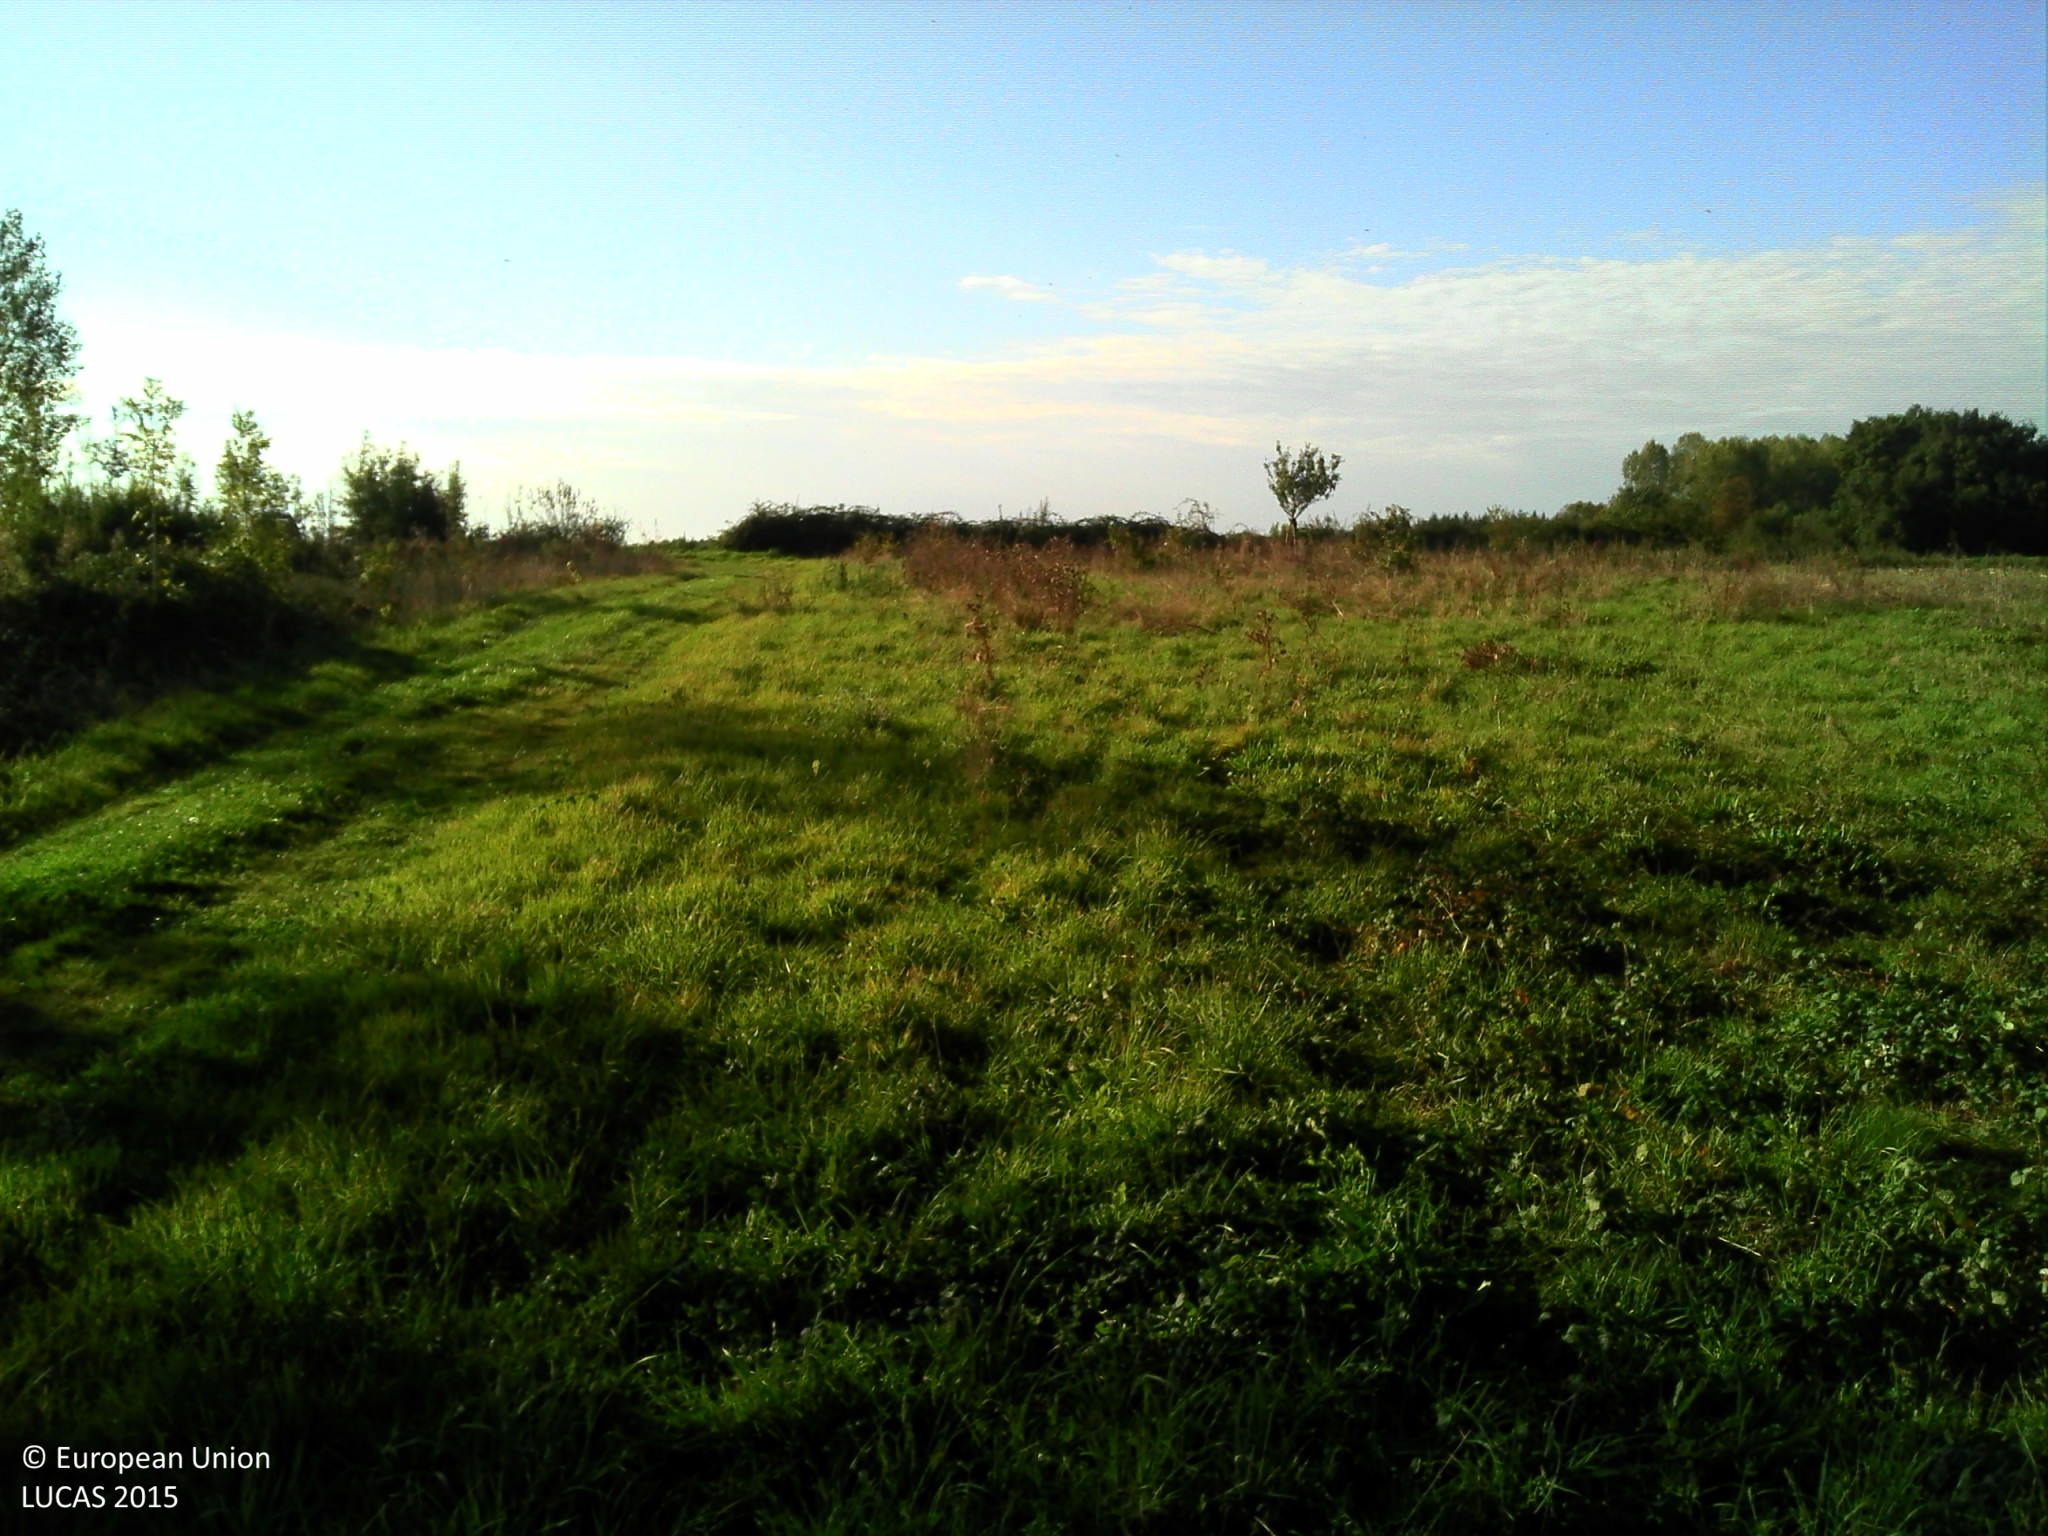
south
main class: Grassland
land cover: Grassland without tree/shrub cover
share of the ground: > 75 %
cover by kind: herbaceous plants 100 %
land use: Agriculture (excluding fallow land and kitchen gardens)
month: September
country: FR
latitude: 46.5932
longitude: -1.0625
